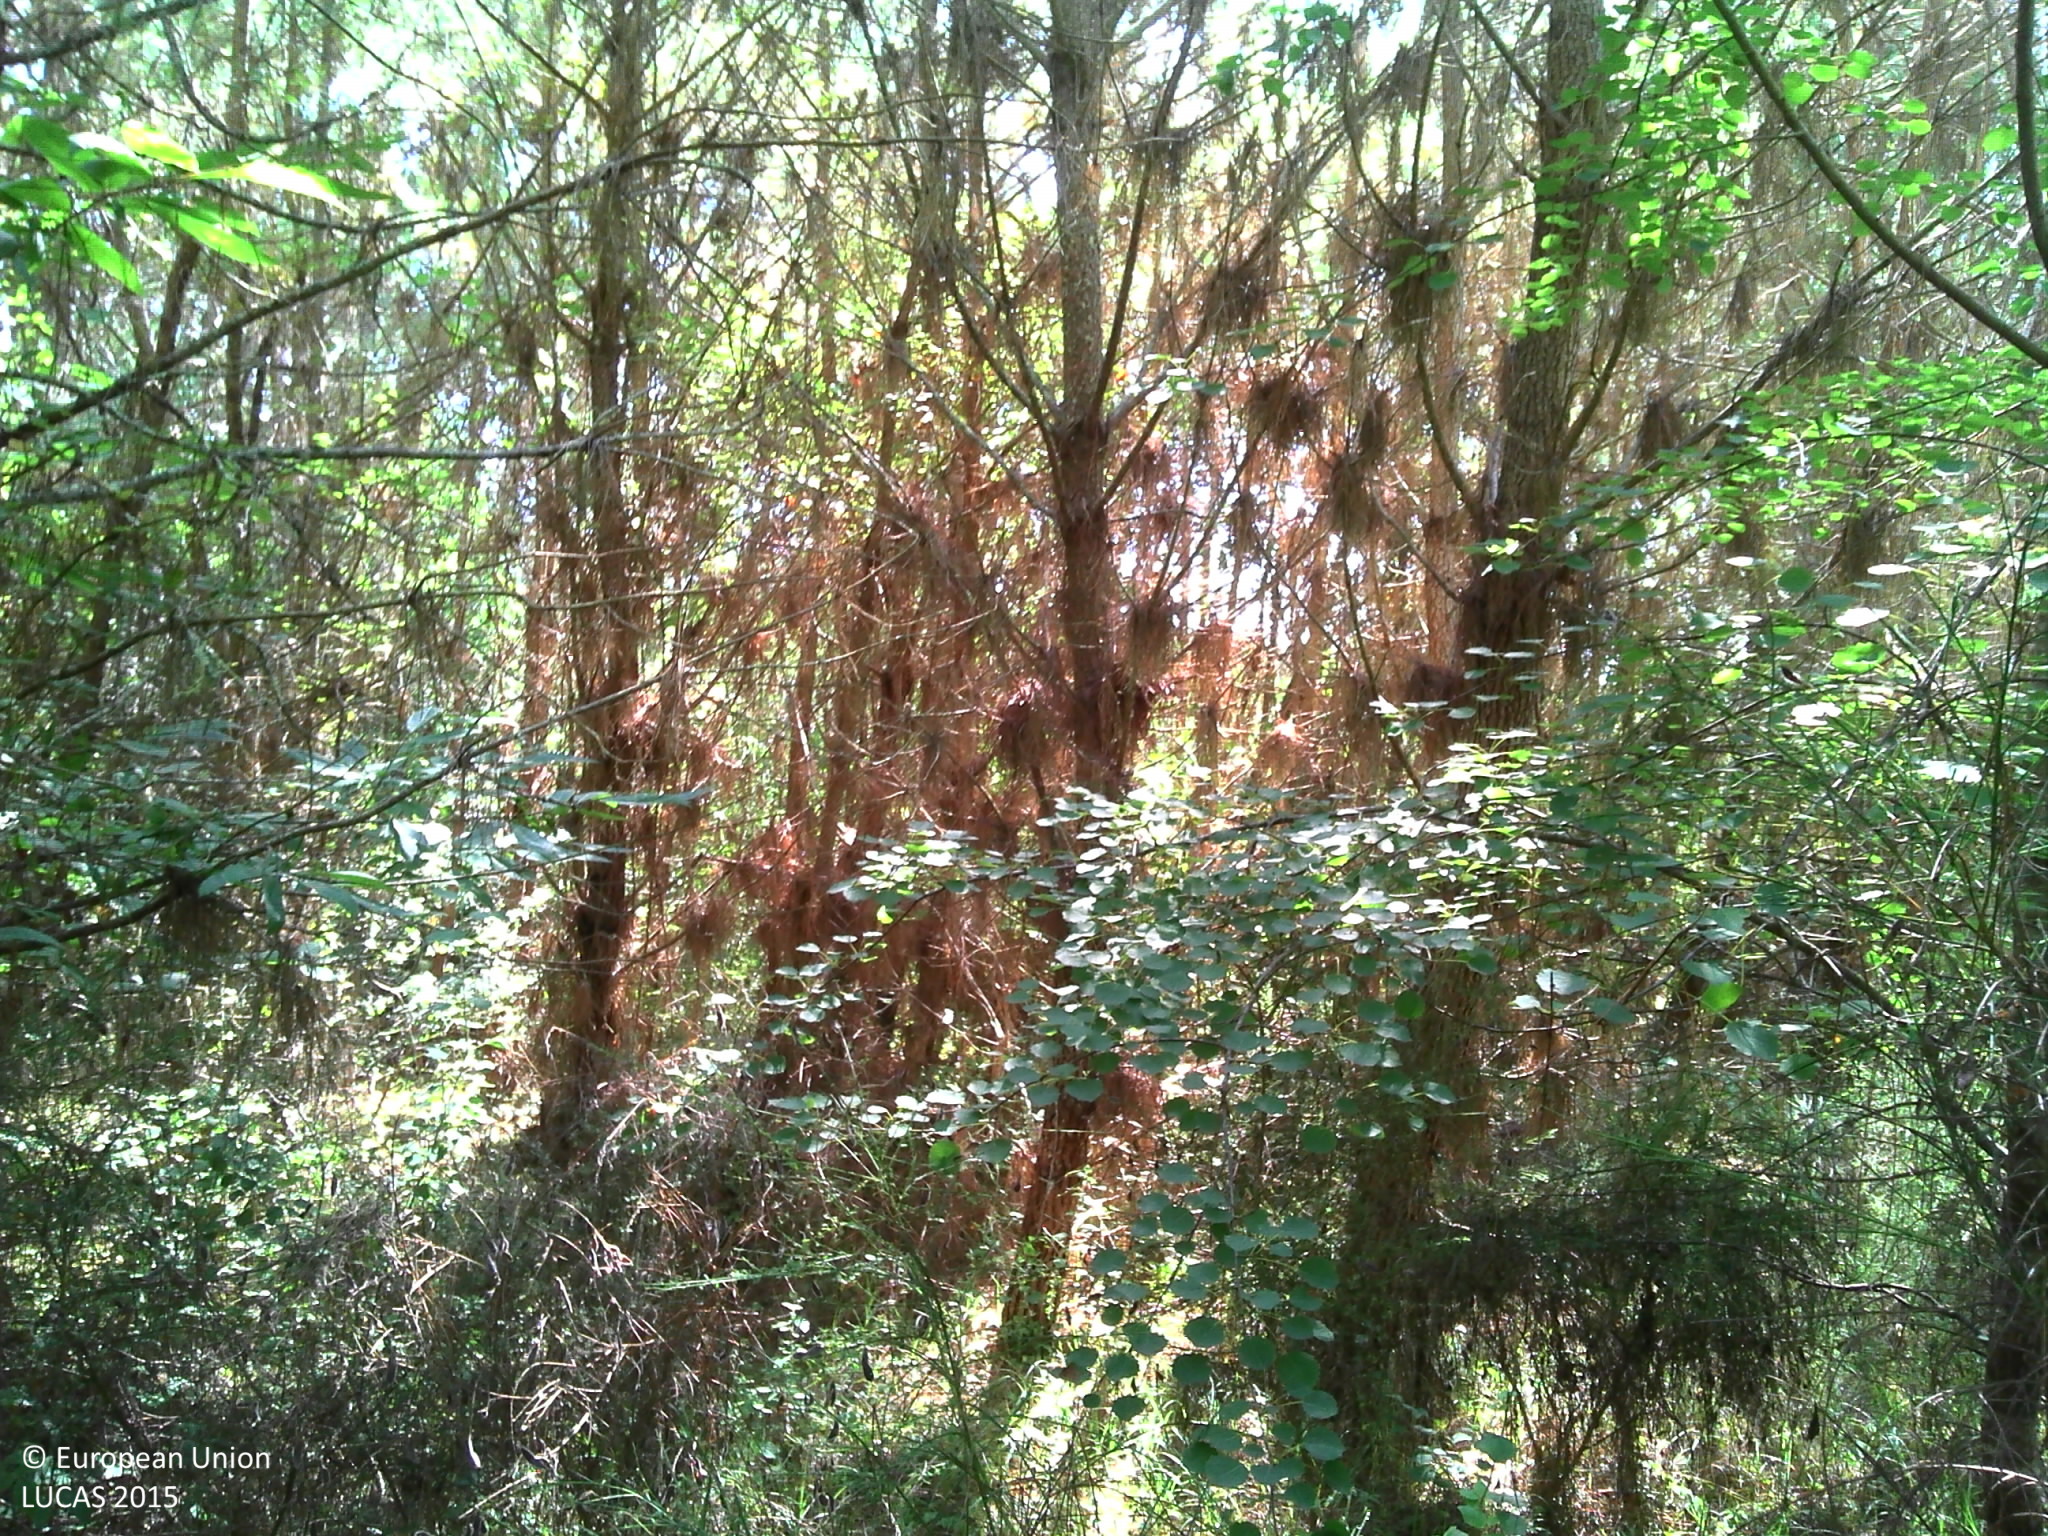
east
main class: Woodland
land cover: Pine dominated mixed woodland
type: thermophilous deciduous forest
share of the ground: > 75 %
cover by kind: coniferous forest trees 50 %, broadleaved forest trees 20 %, shrubs 20 %, herbaceous plants 5 %, lichens and mosses 5 %
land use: Forestry
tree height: > 5 m
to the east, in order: Pine dominated mixed woodland; Shruby margins; Grassland without tree/shrub cover; Shruby margins; Ditches and canals; Fences; Grassland without tree/shrub cover; Fences; Electric lines; Grass margins; Paved roads, cycling and walking lanes; Grass margins; Broadleaved woodland
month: July
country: FR
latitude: 45.0527
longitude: 0.4531
